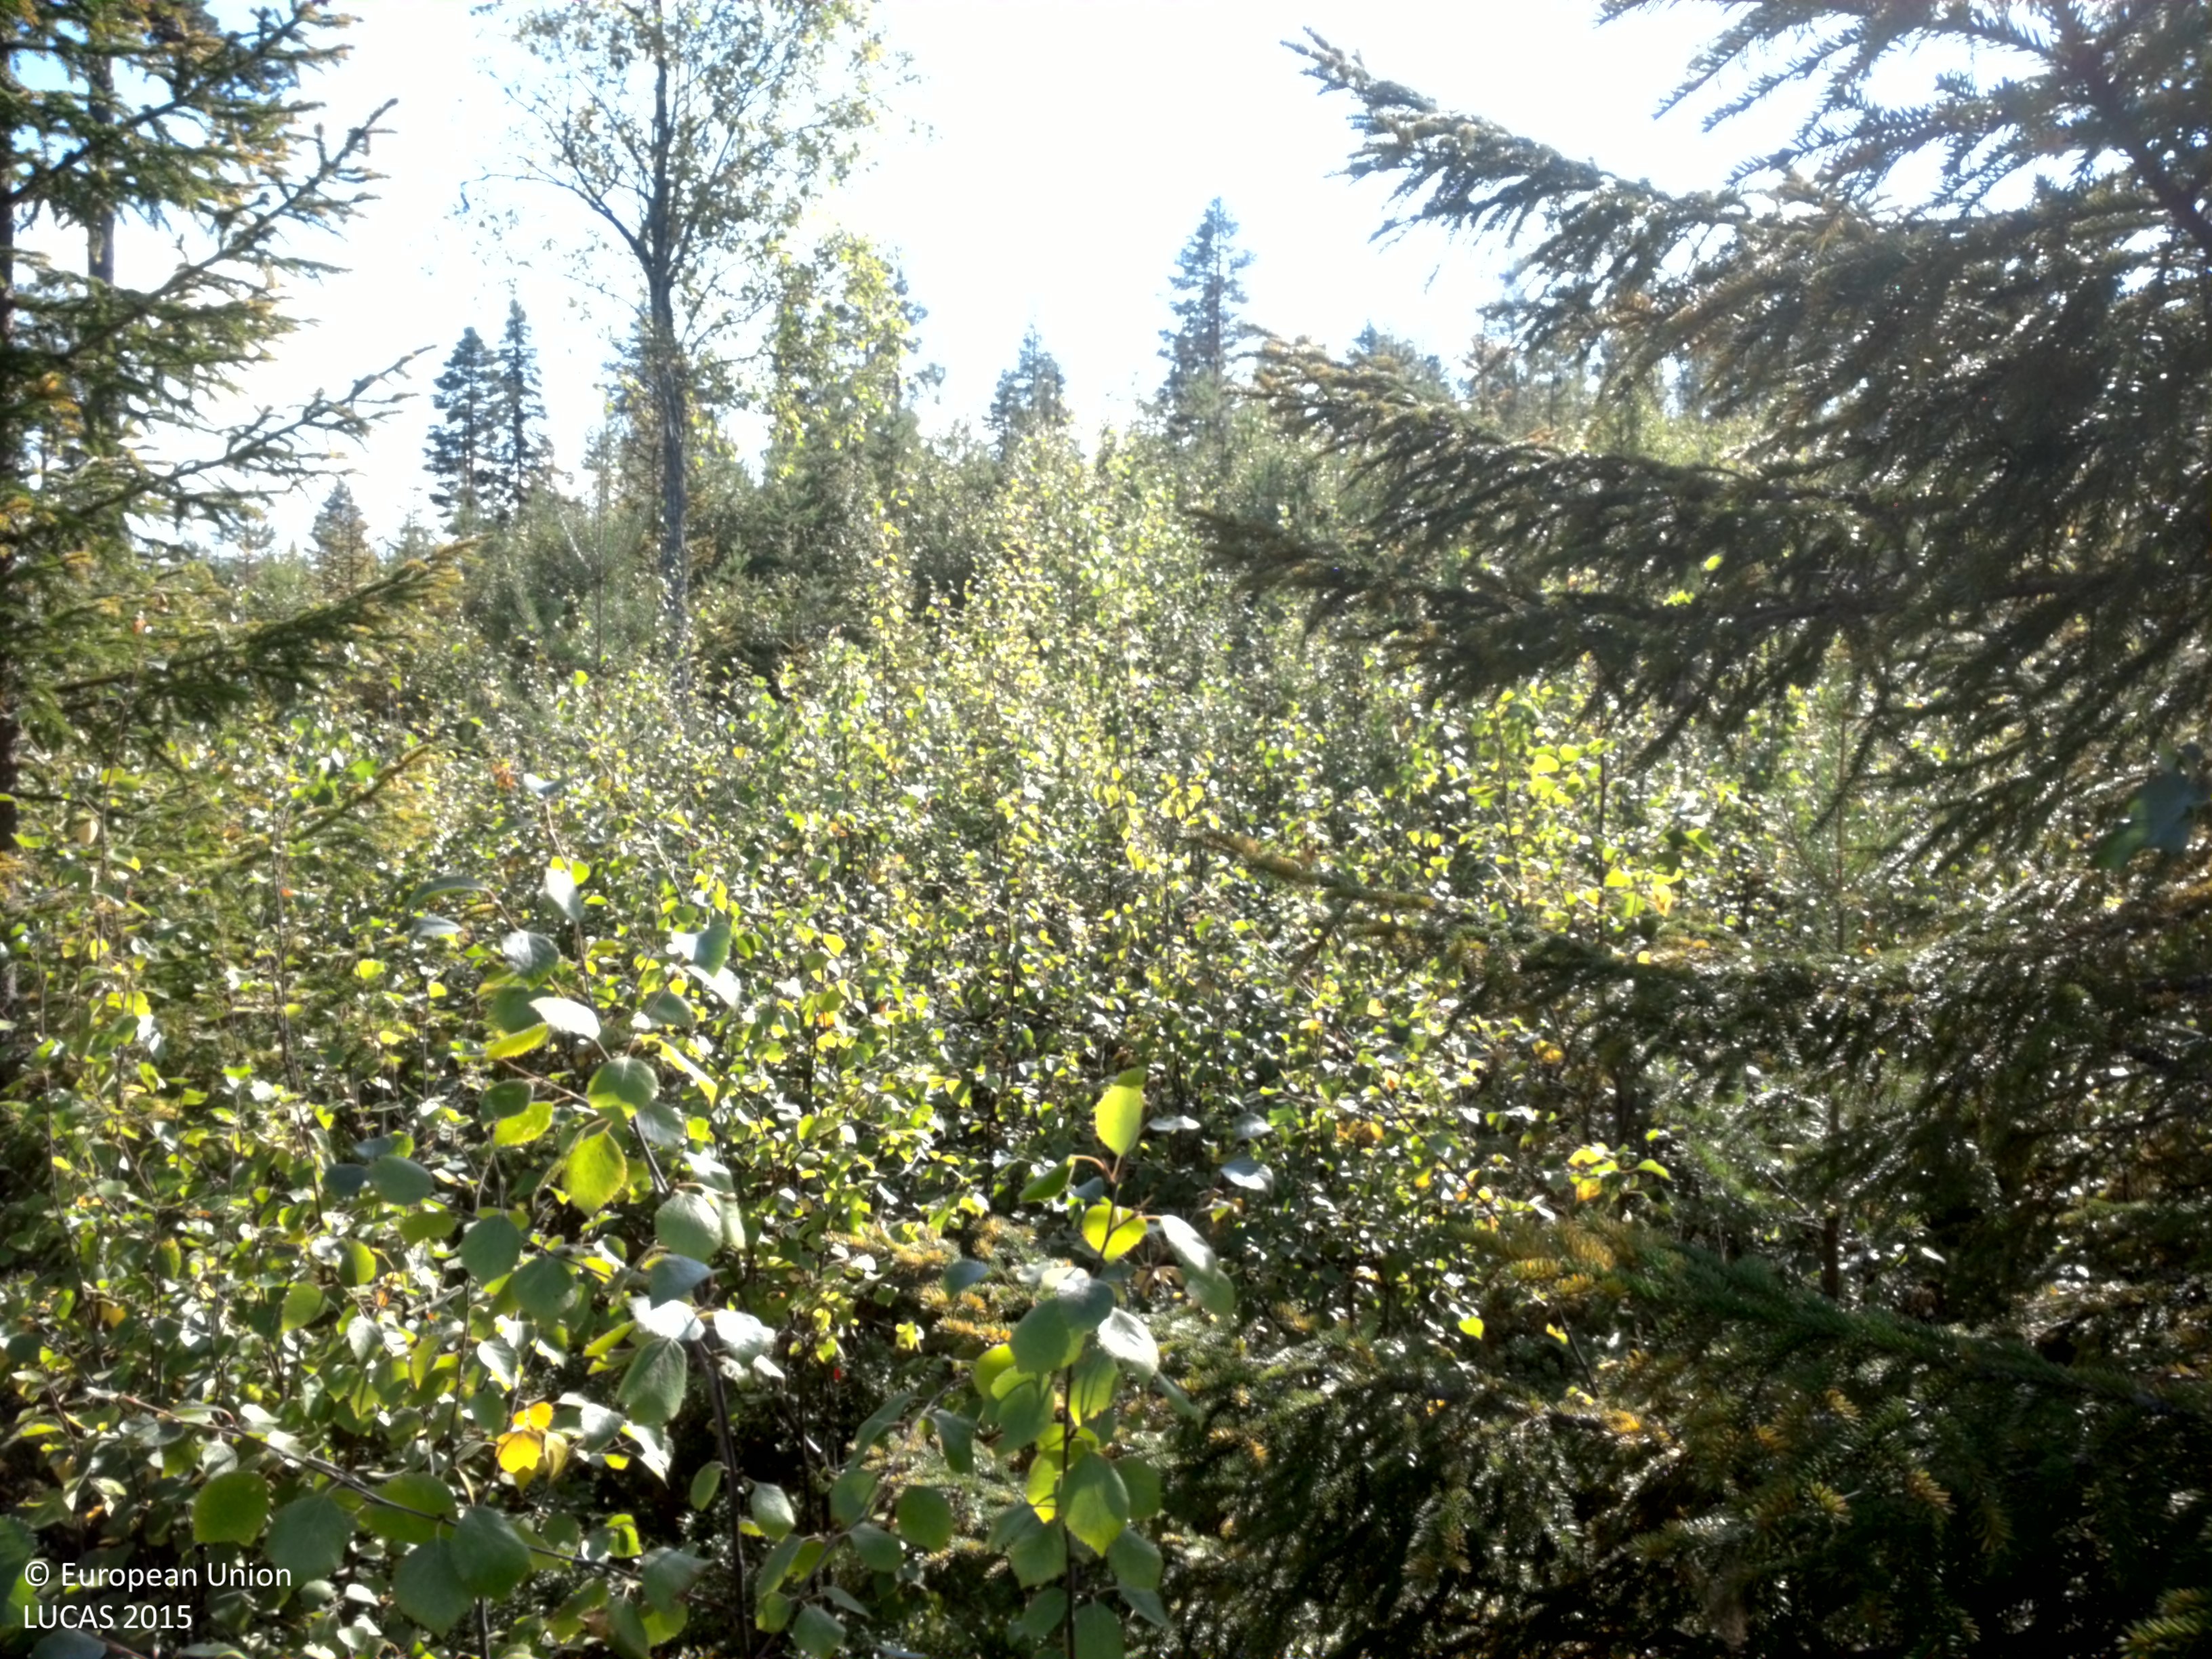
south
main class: Woodland
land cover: Broadleaved woodland
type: boreal forest
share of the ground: > 75 %
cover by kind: broadleaved forest trees 65 %, coniferous forest trees 15 %, herbaceous plants 10 %, shrubs 5 %, lichens and mosses 5 %
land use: Forestry
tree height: > 5 m
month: August
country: SE
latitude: 64.5226
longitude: 19.0331
